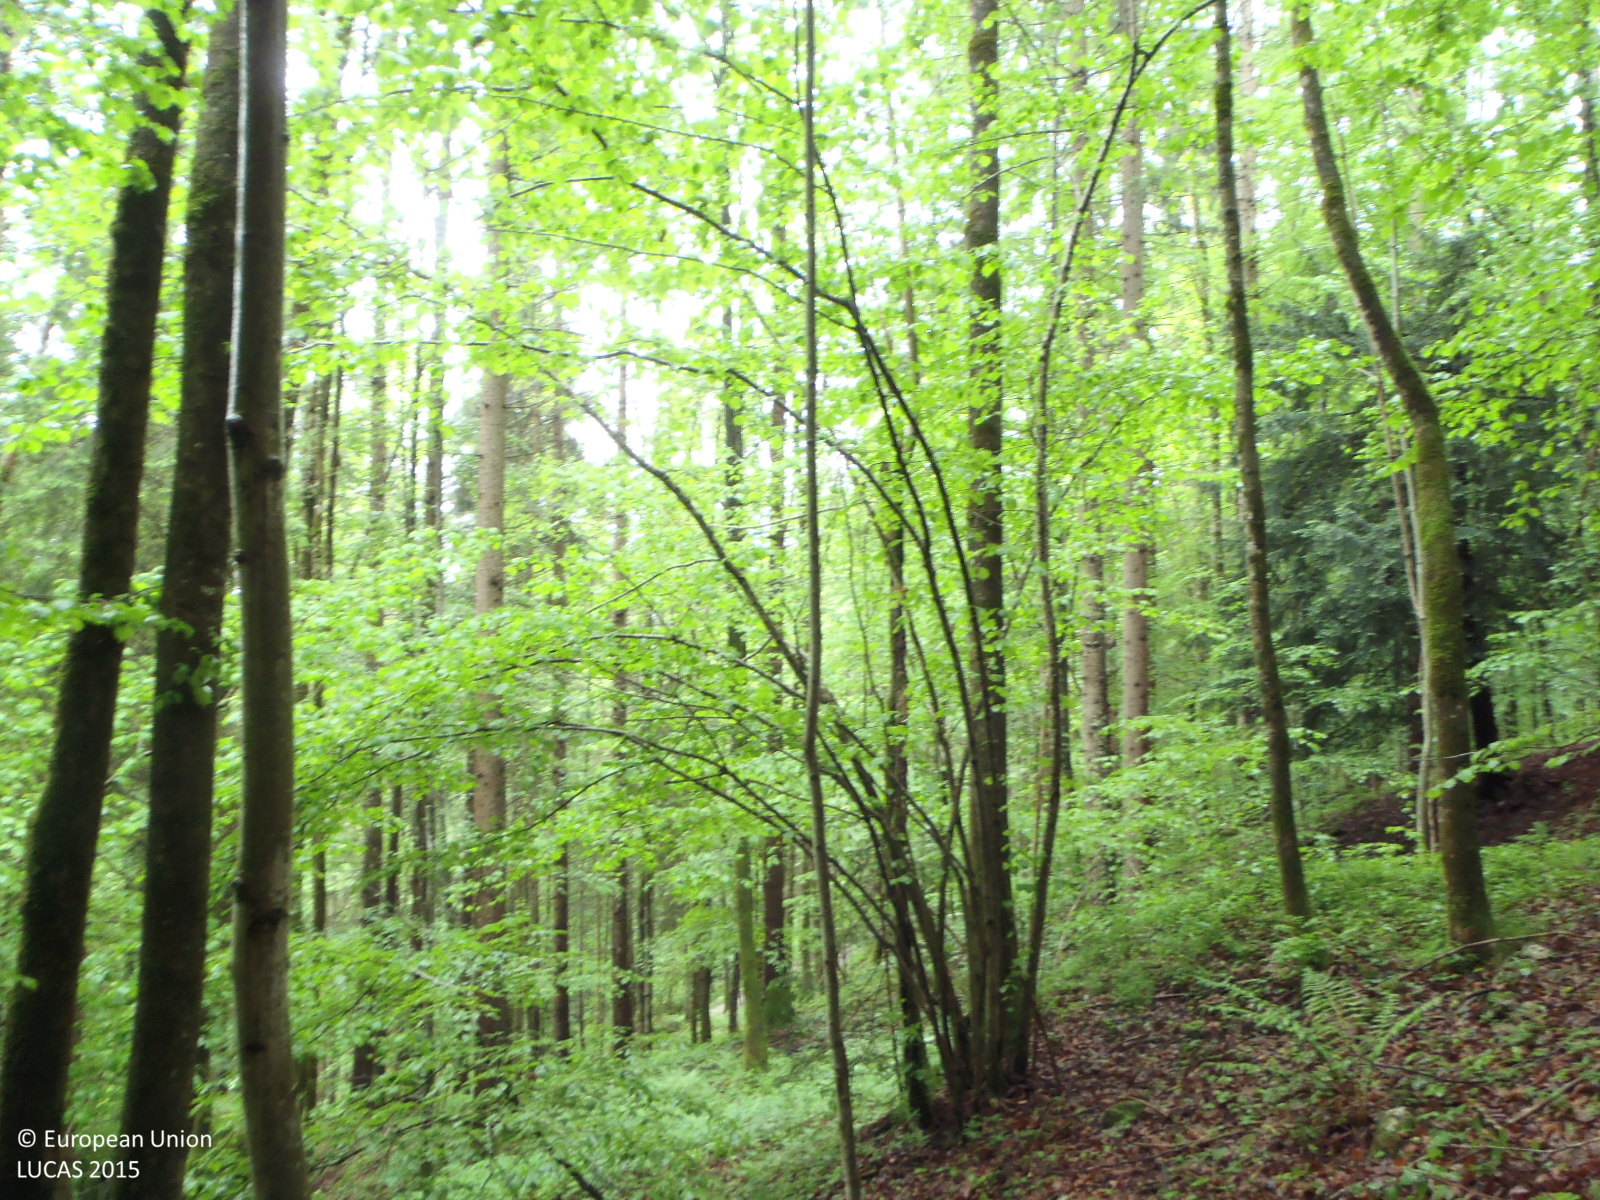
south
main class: Woodland
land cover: Broadleaved woodland
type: mountainous beech forest
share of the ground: > 75 %
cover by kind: broadleaved forest trees 75 %, shrubs 10 %, coniferous forest trees 5 %, herbaceous plants 5 %, unconsolidated bare surface 5 %
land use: Forestry
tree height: > 5 m
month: May
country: AT
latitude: 47.6143
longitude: 12.6991
